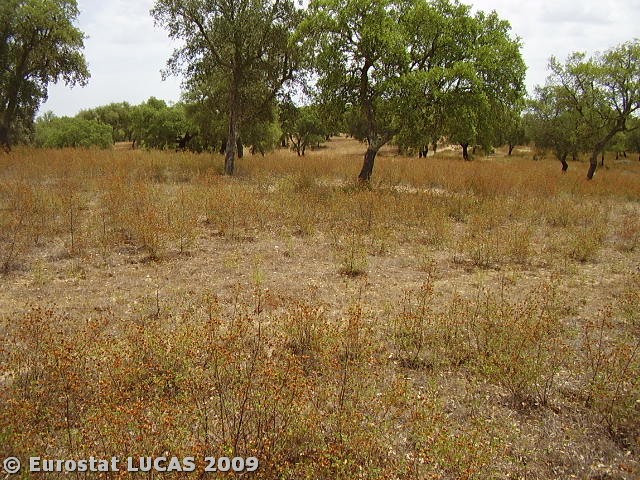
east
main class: Woodland
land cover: Broadleaved woodland
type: broadleaved evergreen forest
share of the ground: < 10 %
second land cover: Spontaneously vegetated surfaces
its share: 25 - 50 %
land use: Forestry
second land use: Fallow land
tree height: > 5 m
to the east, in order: Broadleaved woodland; Spontaneously vegetated surfaces; Bare land; Tracks; Broadleaved woodland; Tracks; Broadleaved woodland
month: June
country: PT
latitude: 38.3998
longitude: -7.8167
